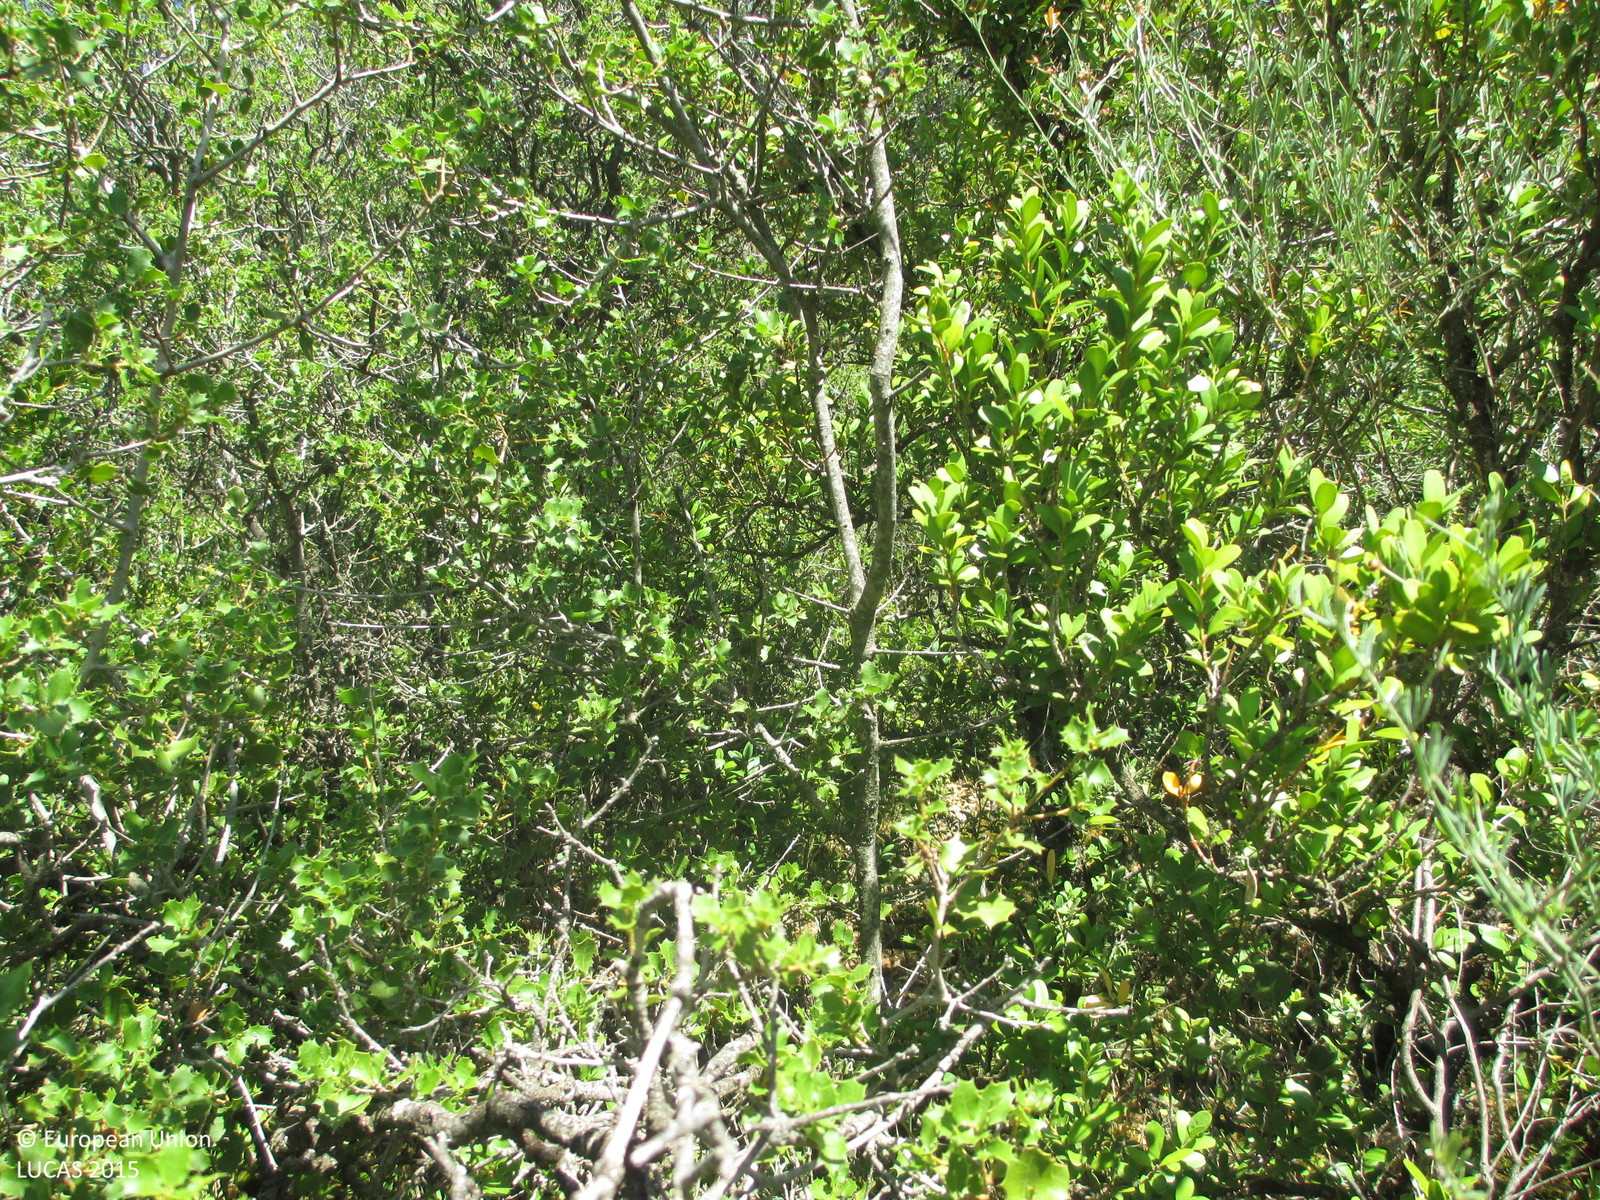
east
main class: Woodland
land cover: Broadleaved woodland
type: broadleaved evergreen forest
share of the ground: > 75 %
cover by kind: broadleaved forest trees 95 %, shrubs 5 %
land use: Semi-natural and natural areas not in use
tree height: < 5 m
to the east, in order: Broadleaved woodland; Tracks; Barley; Other leguminous and mixtures for fodder
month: June
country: ES
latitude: 42.1894
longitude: -0.2294
